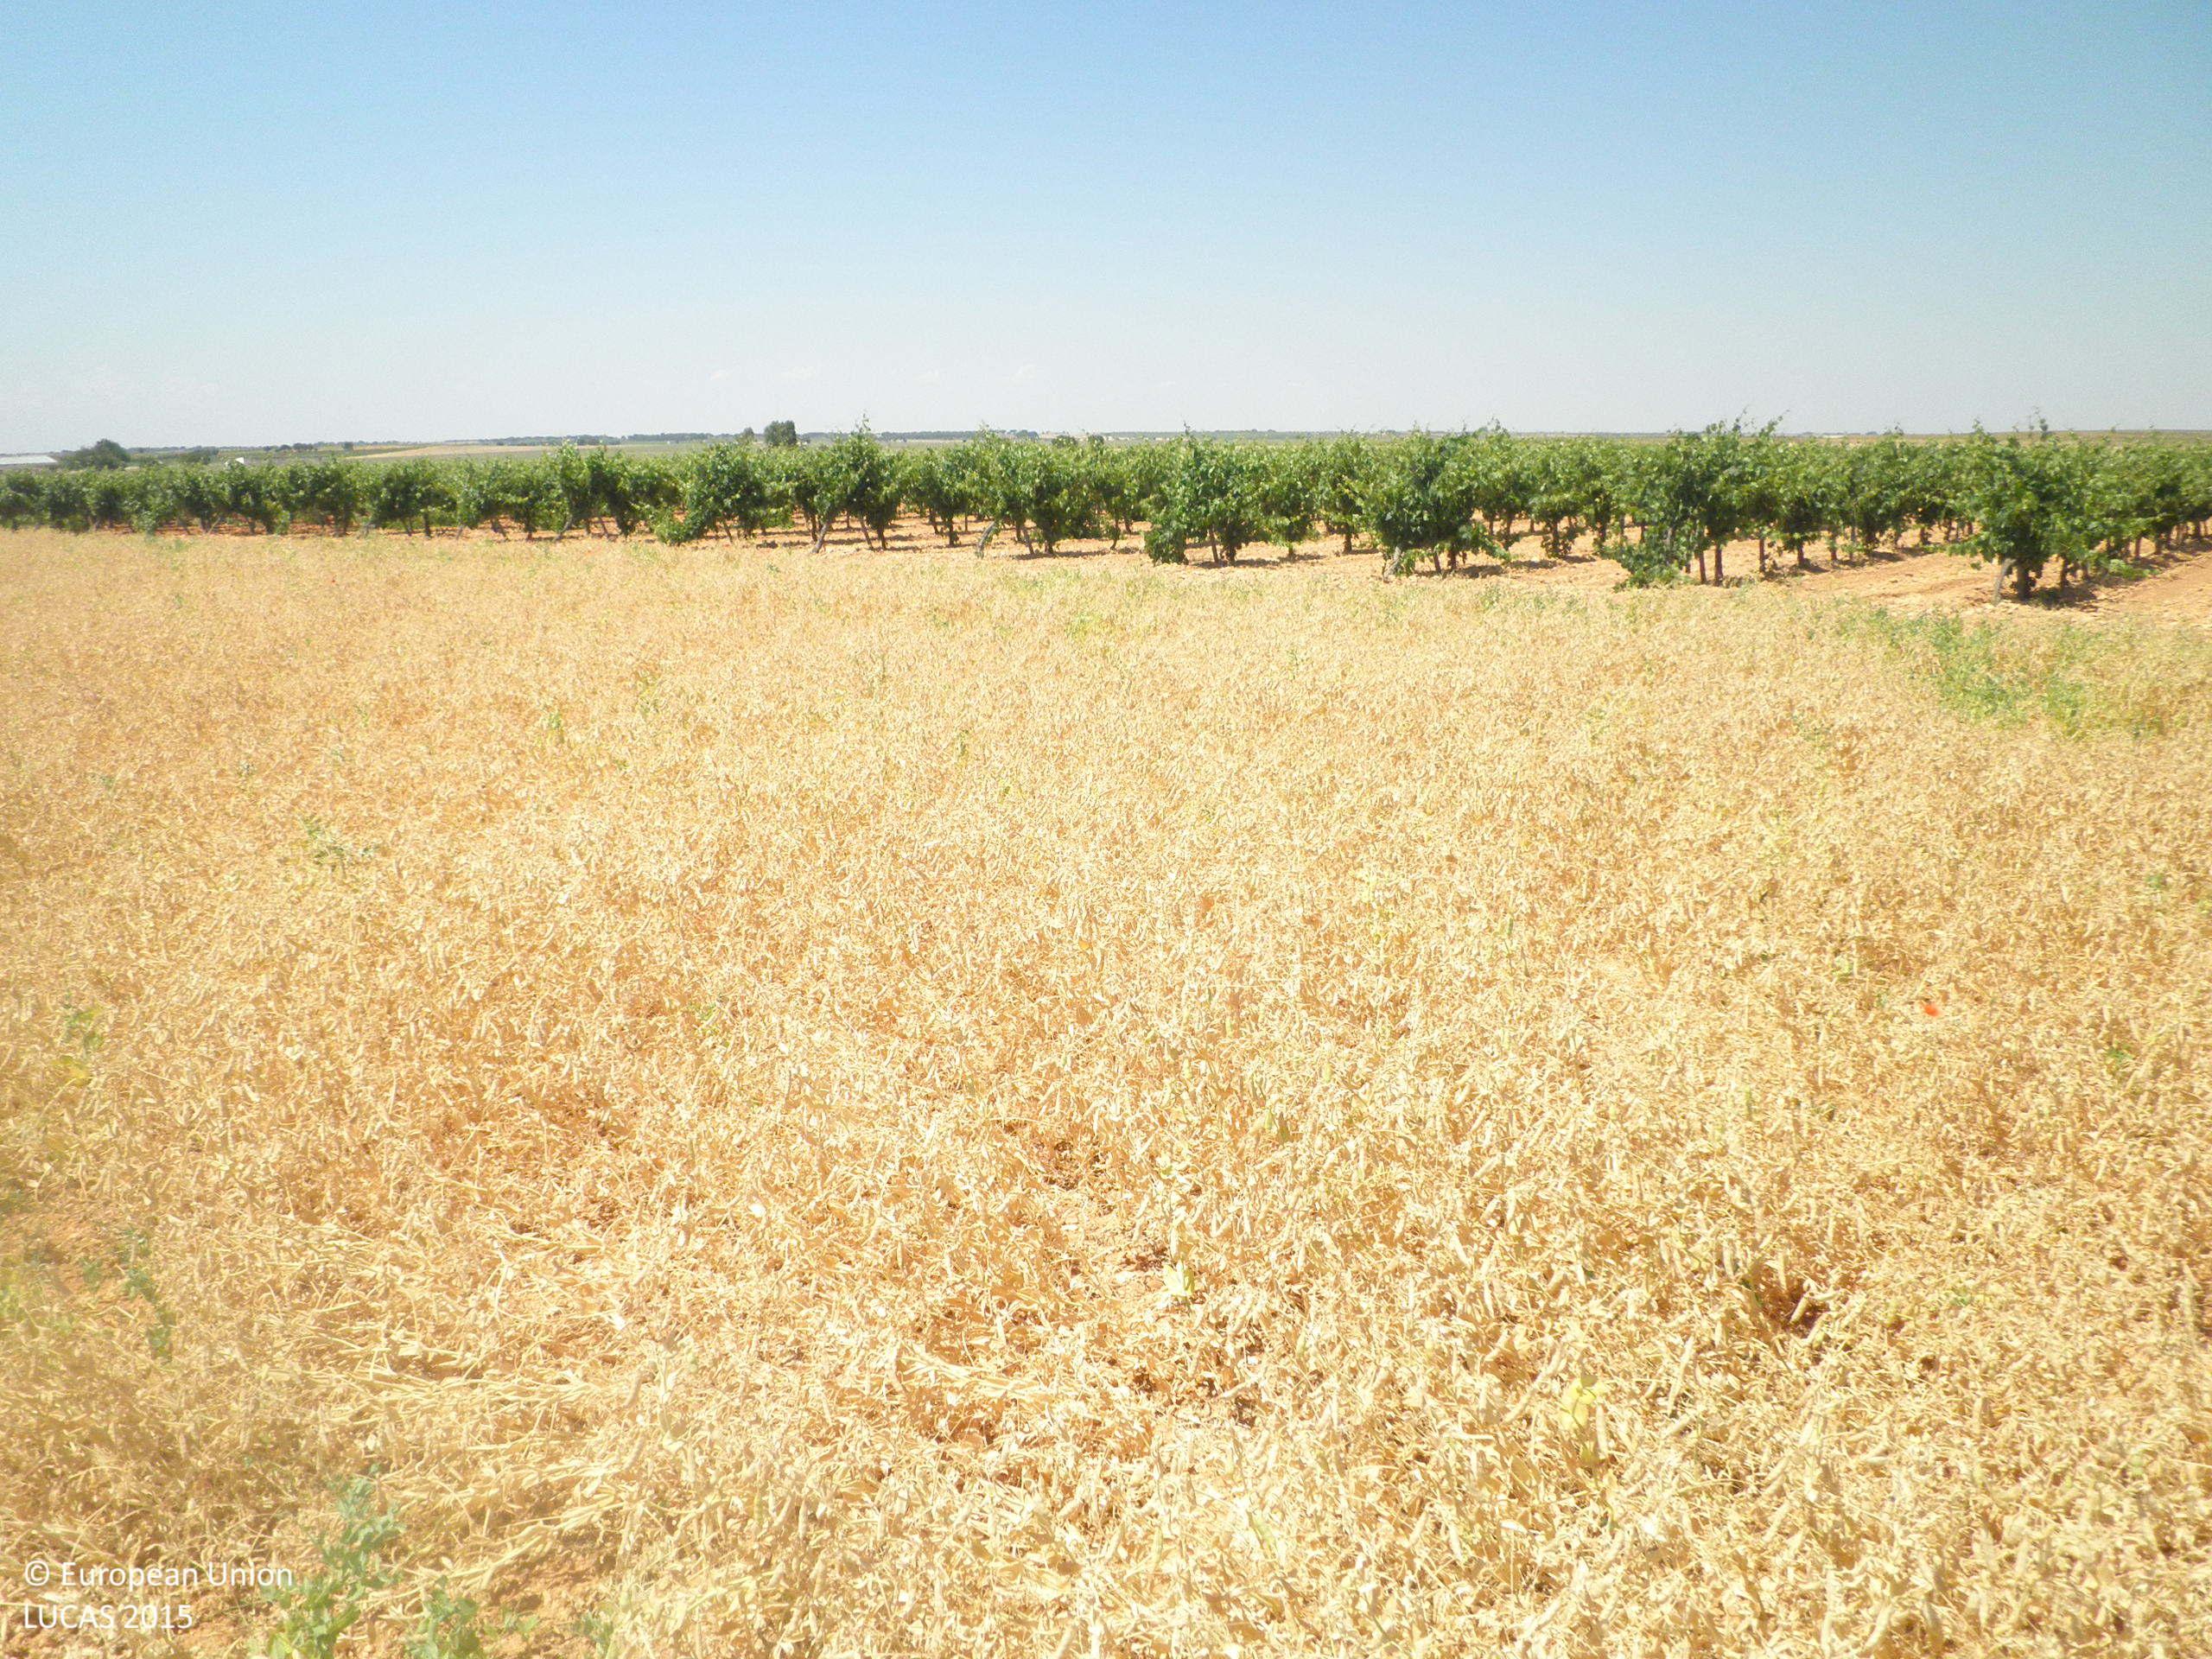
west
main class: Cropland
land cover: Dry pulses
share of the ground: > 75 %
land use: Agriculture (excluding fallow land and kitchen gardens)
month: June
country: ES
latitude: 39.2944
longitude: -1.8190
